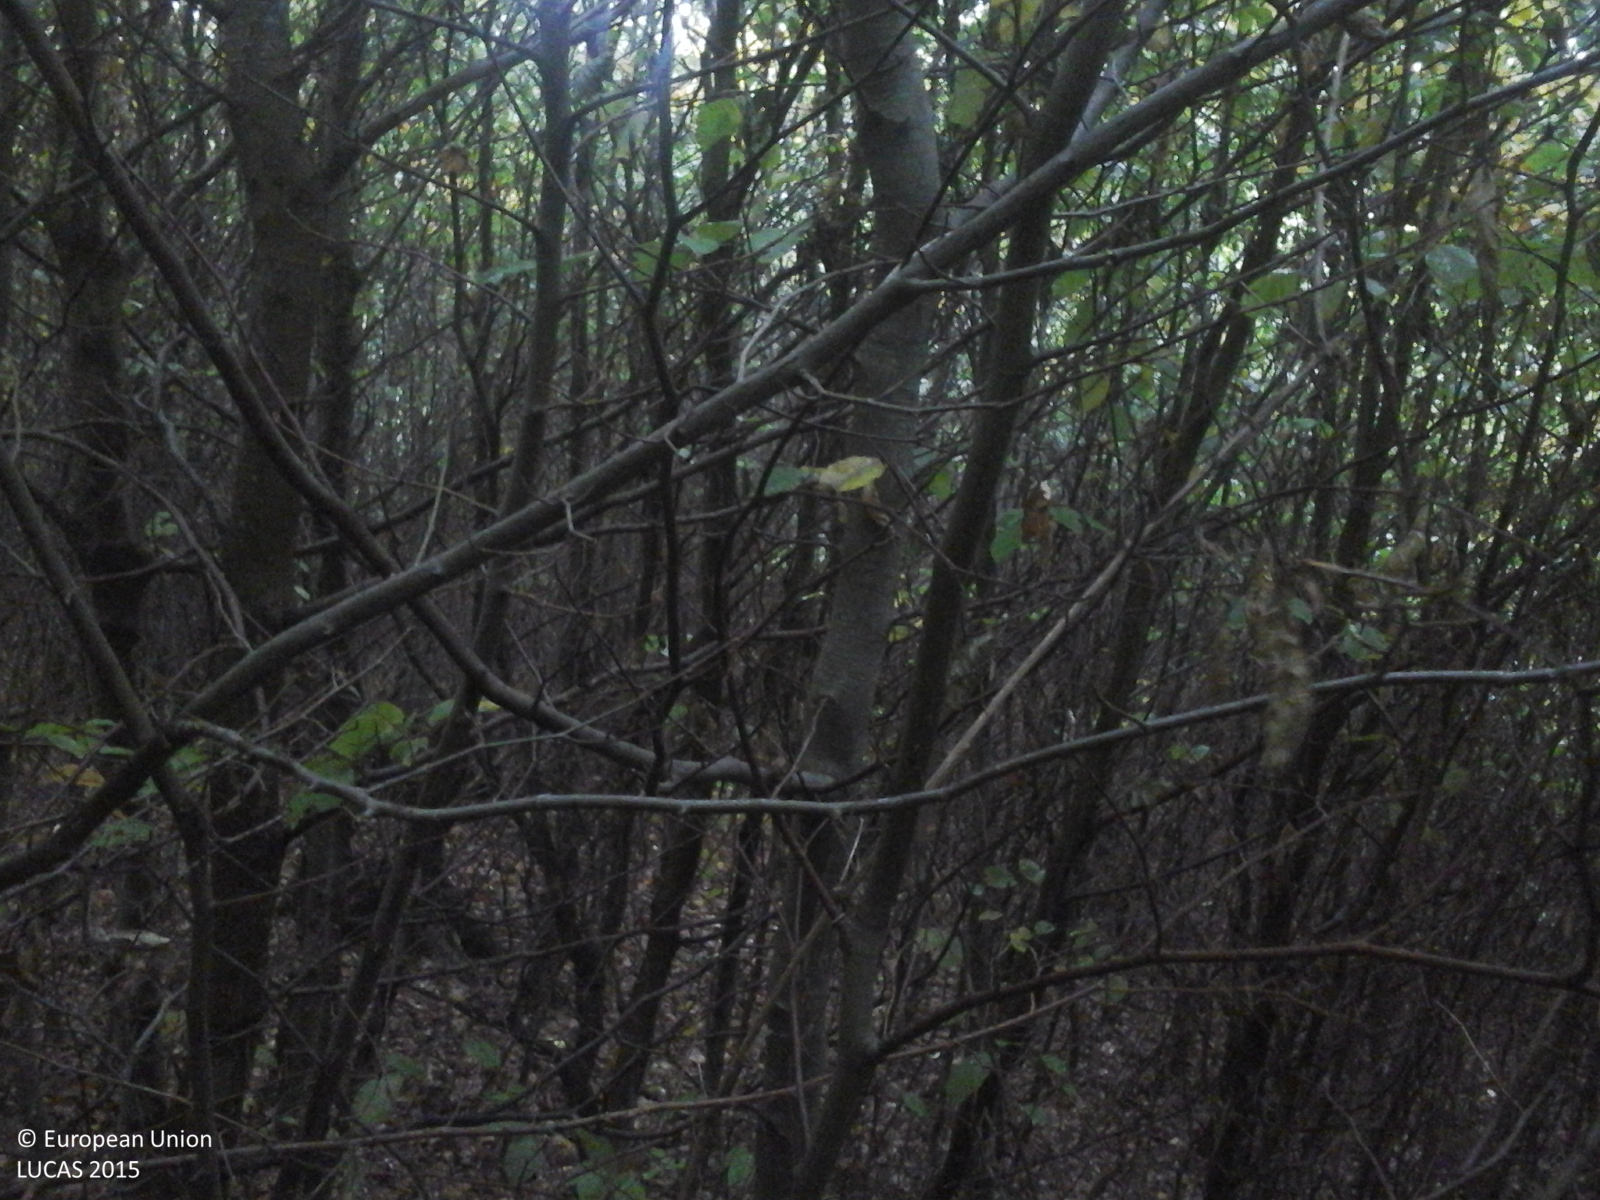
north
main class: Woodland
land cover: Broadleaved woodland
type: beech forest
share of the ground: > 75 %
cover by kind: broadleaved forest trees 100 %
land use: Forestry
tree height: < 5 m
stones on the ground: < 10 %
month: October
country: RO
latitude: 46.3689
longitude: 24.9799
